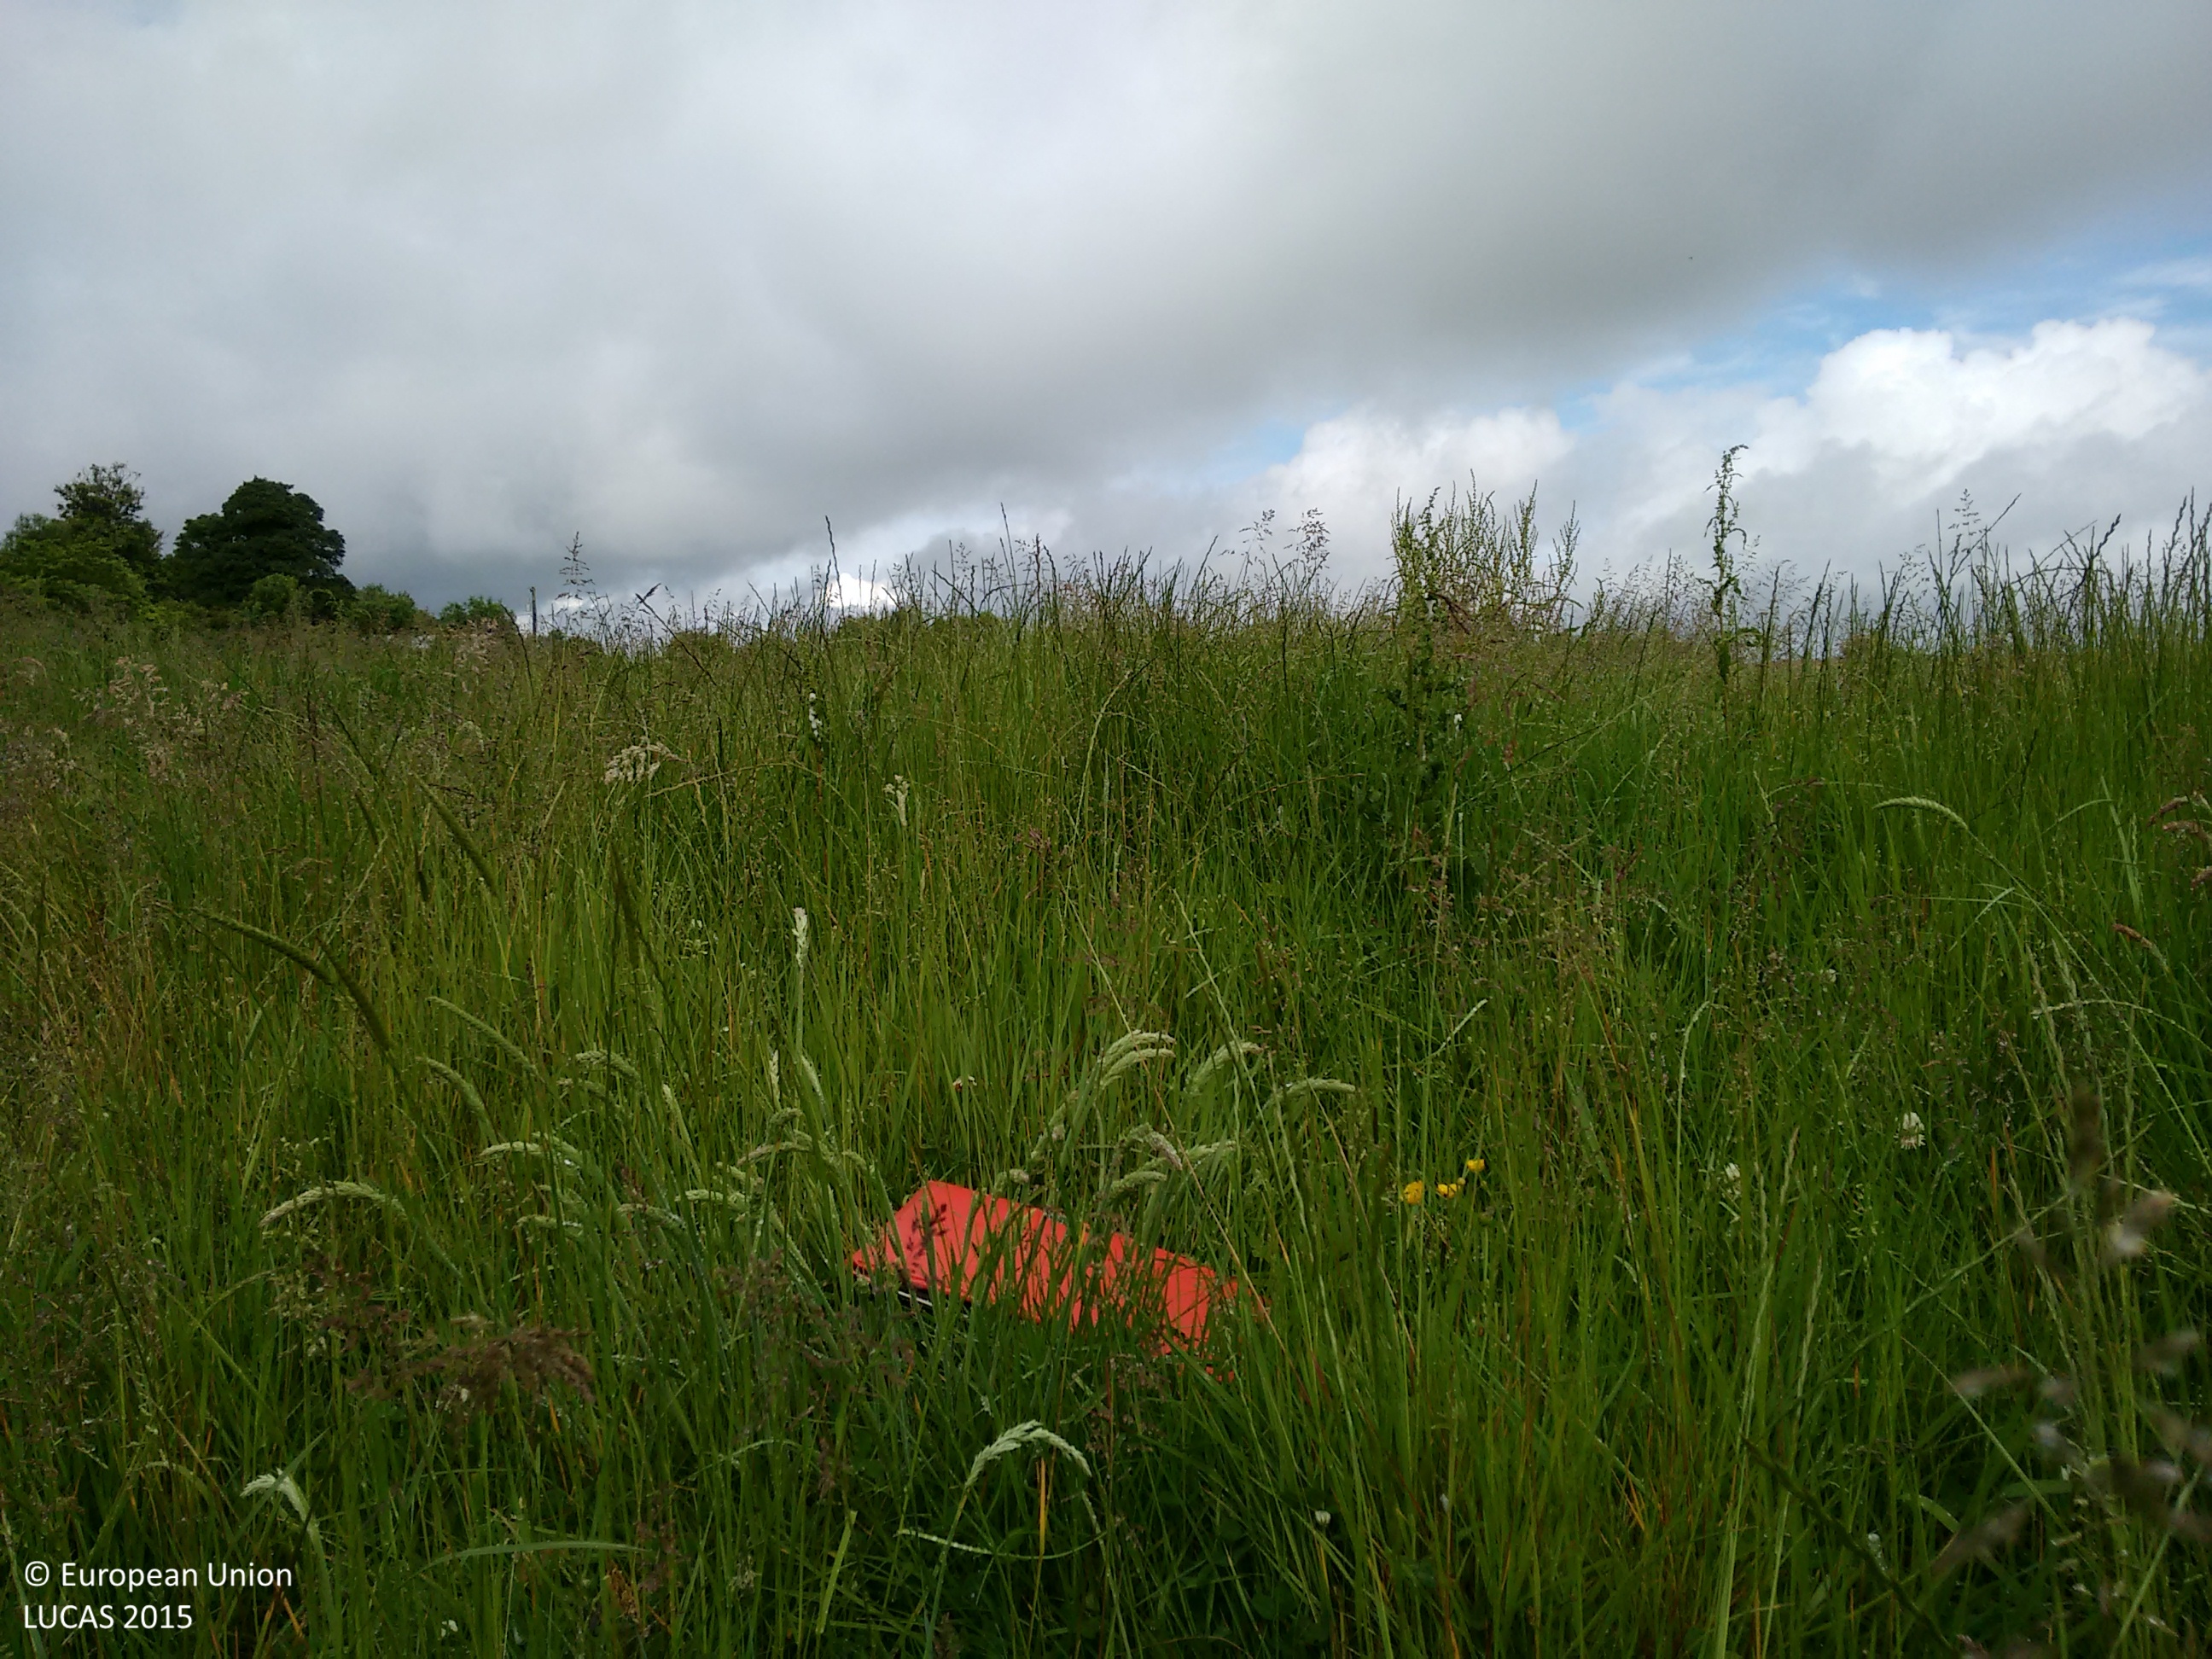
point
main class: Grassland
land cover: Grassland without tree/shrub cover
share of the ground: > 75 %
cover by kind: herbaceous plants 100 %
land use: Agriculture (excluding fallow land and kitchen gardens)
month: June
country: IE
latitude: 53.6556
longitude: -6.7632
